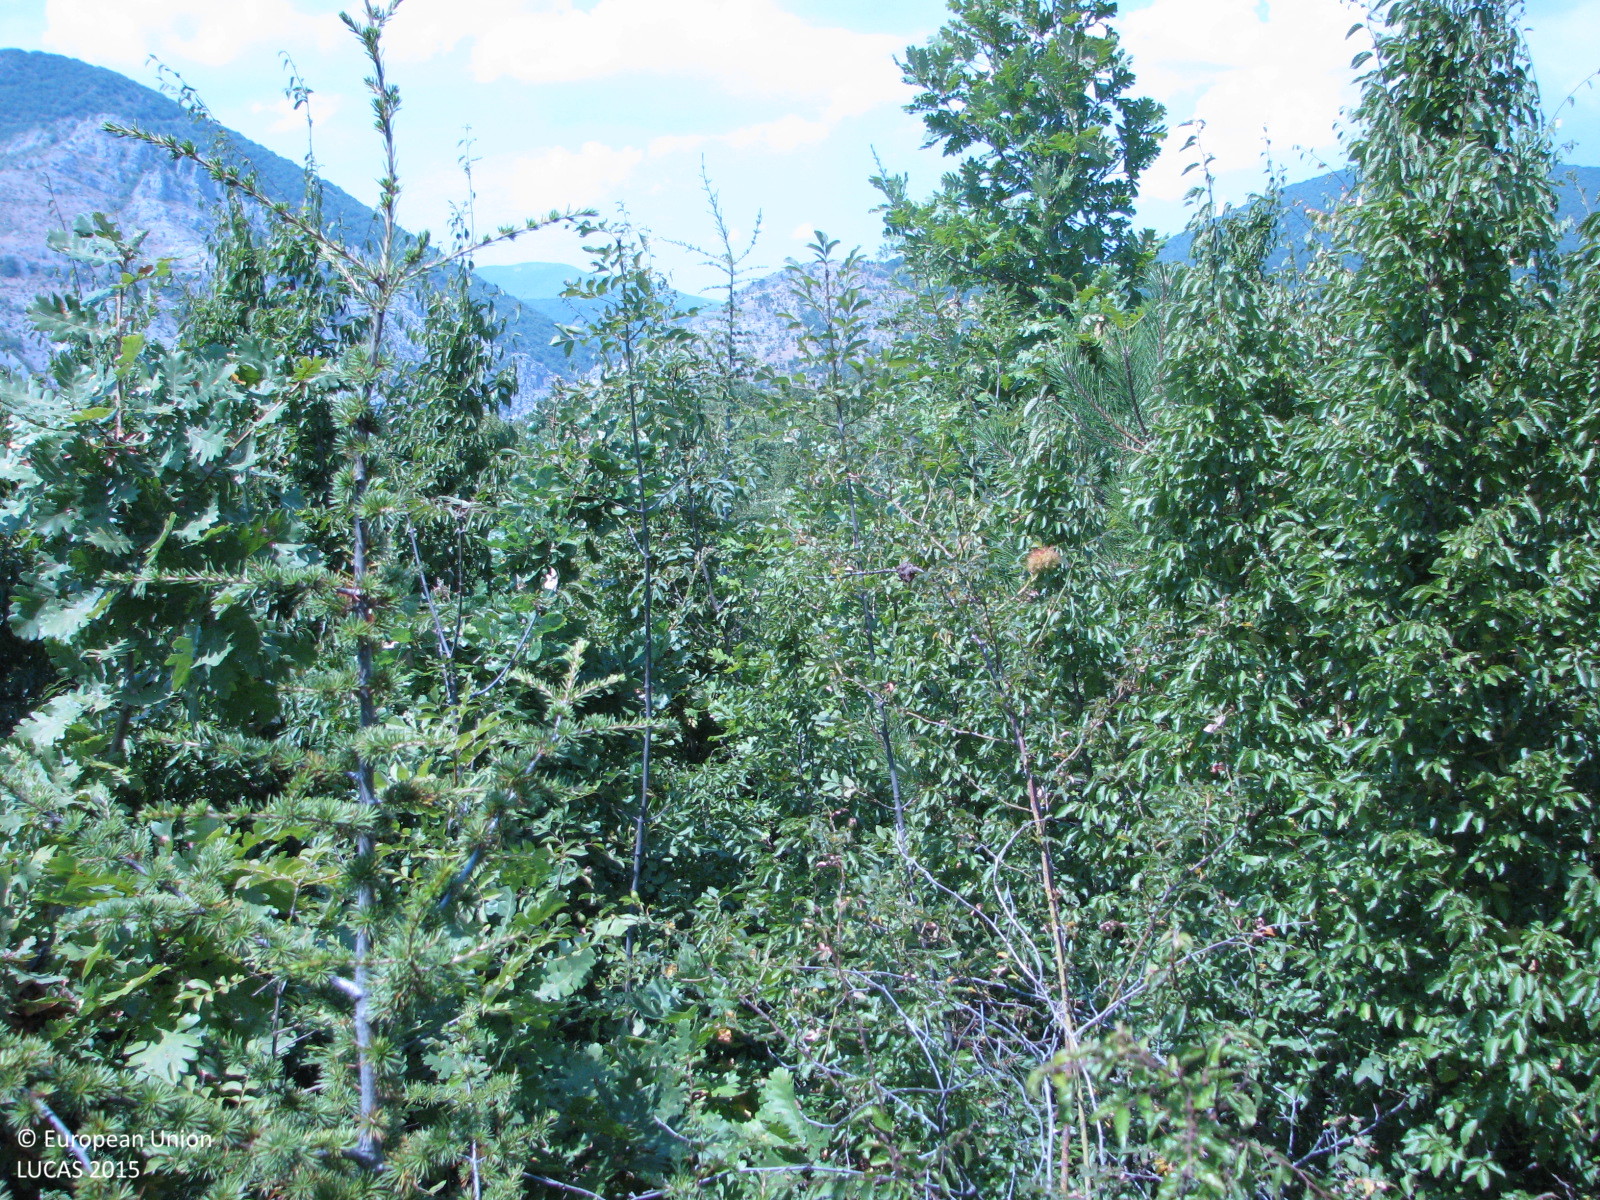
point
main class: Woodland
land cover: Broadleaved woodland
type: hemiboreal forest and nemoral coniferous forest and mixed broadleaved-coniferous forest
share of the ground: 50 - 75 %
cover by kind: broadleaved forest trees 40 %, herbaceous plants 30 %, shrubs 20 %, coniferous forest trees 10 %
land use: Forestry
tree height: > 5 m
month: July
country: BG
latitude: 42.6818
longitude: 26.0843
